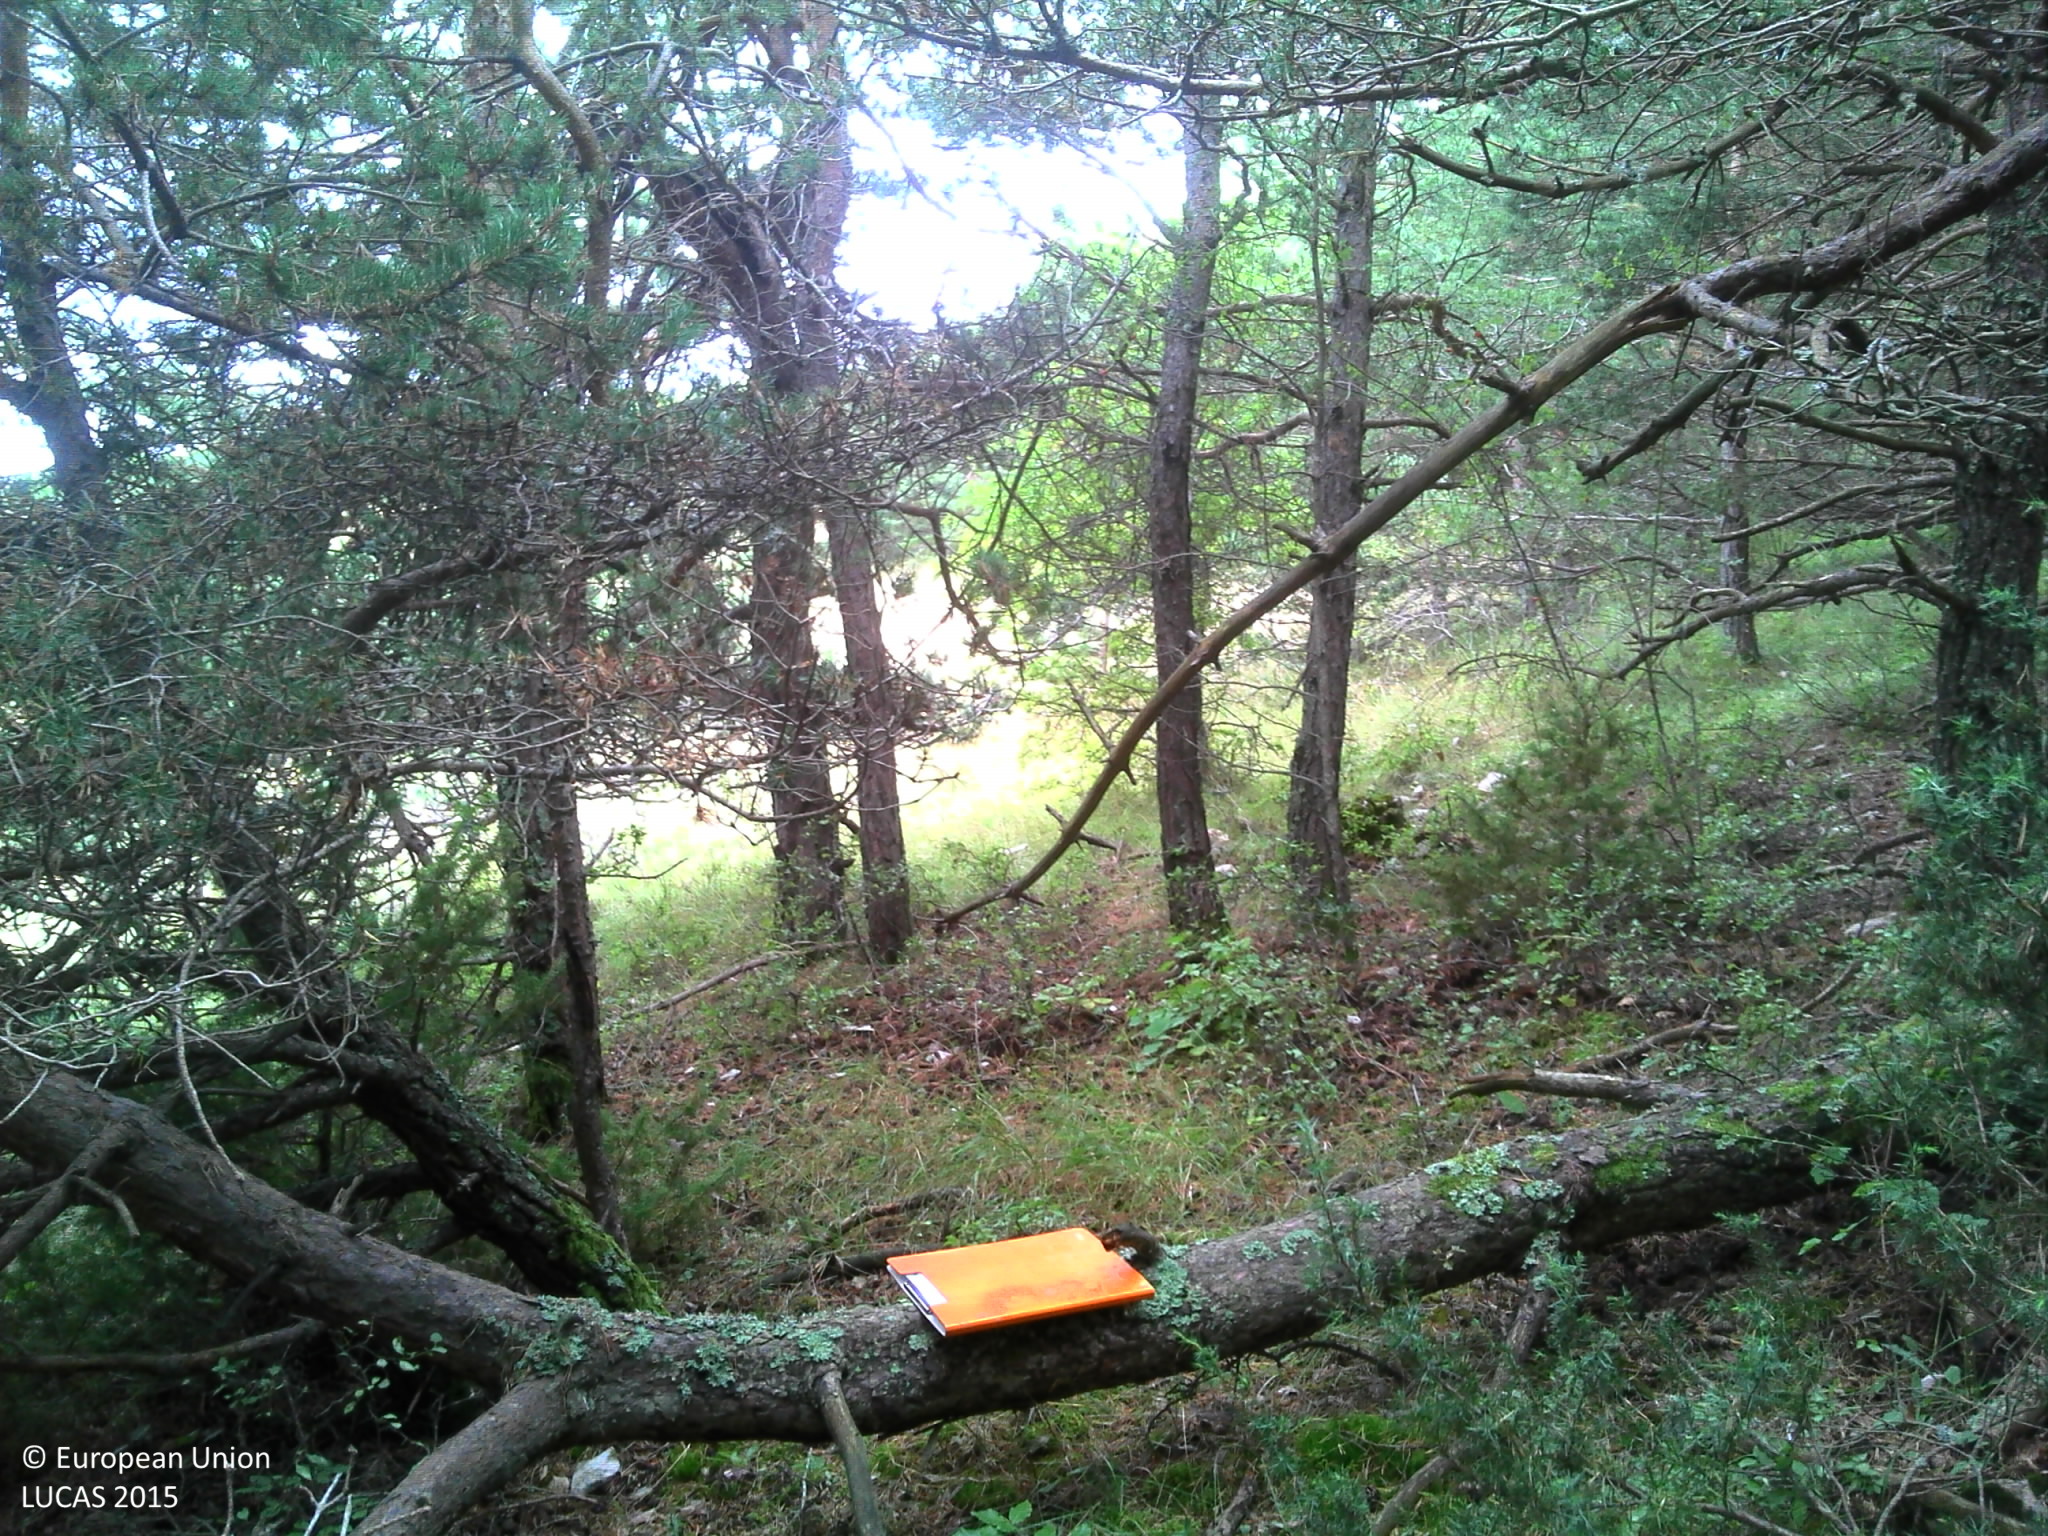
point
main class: Woodland
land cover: Pine dominated coniferous woodland
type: alpine coniferous forest
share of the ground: > 75 %
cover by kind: coniferous forest trees 90 %, broadleaved forest trees 5 %, herbaceous plants 5 %
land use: Forestry
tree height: > 5 m
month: September
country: FR
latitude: 44.5337
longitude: 5.3130
